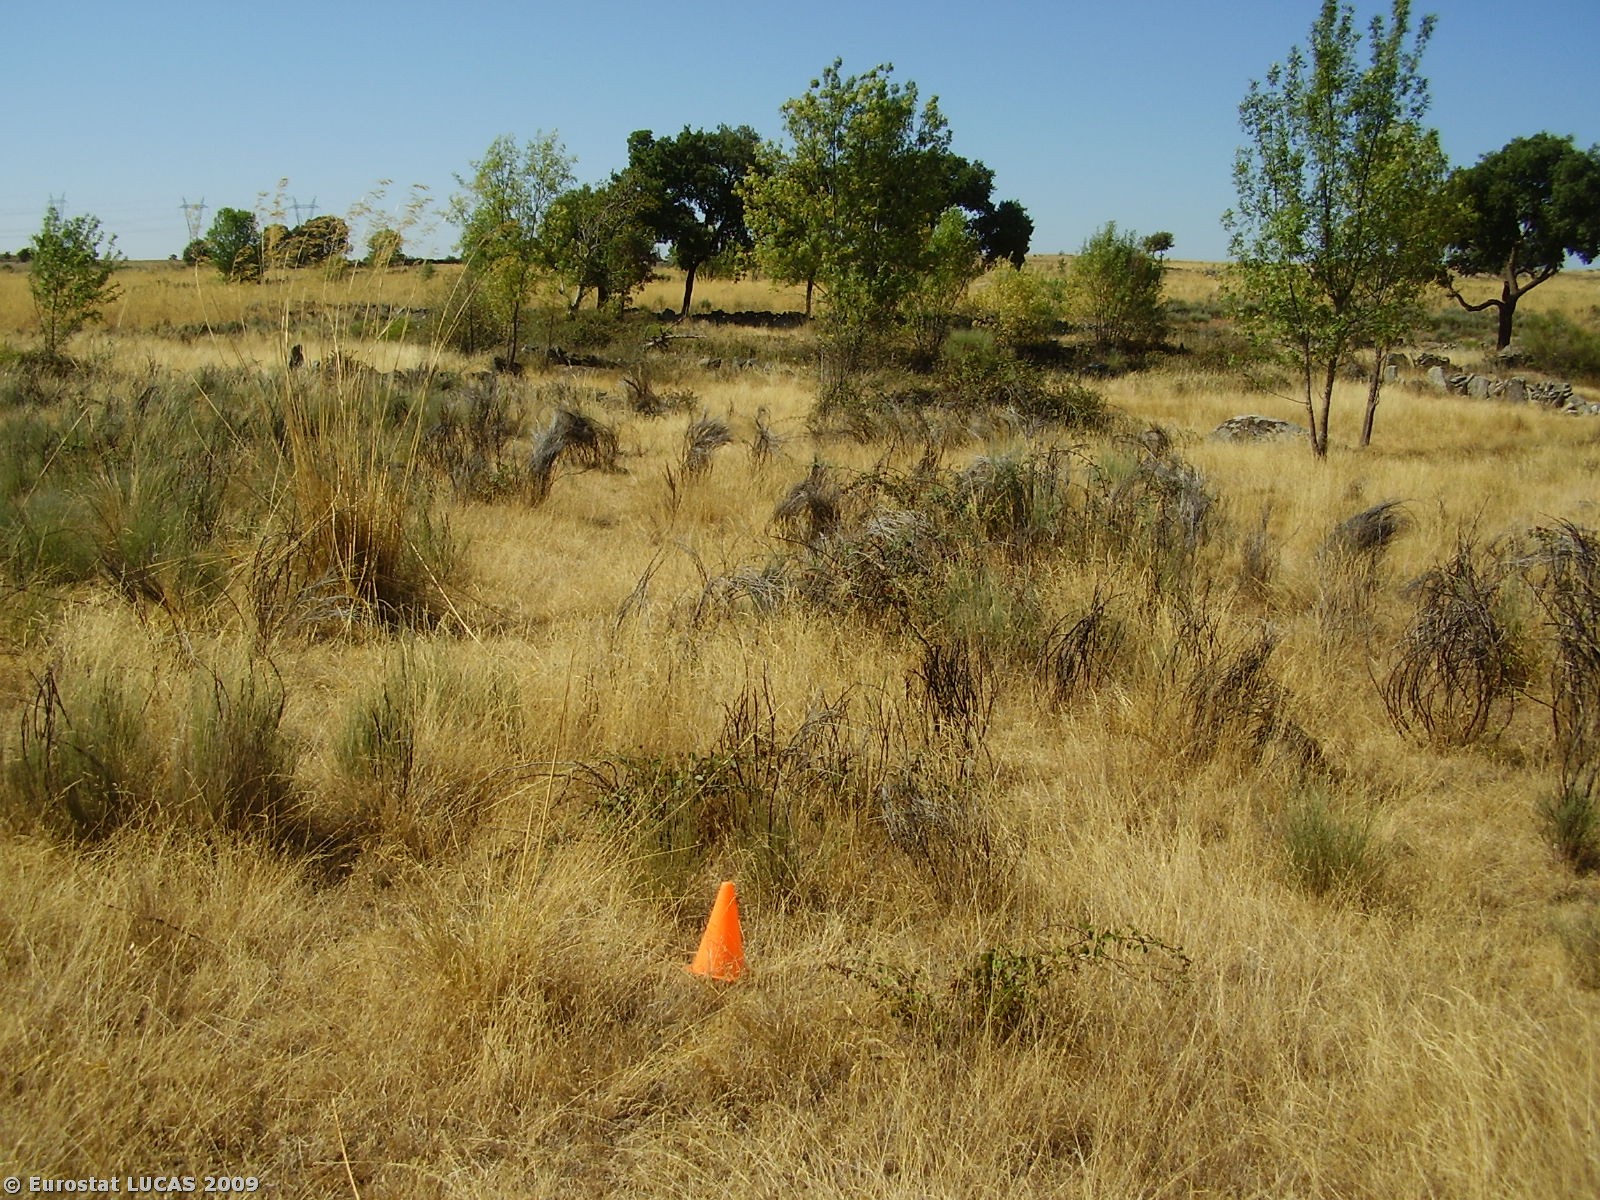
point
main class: Grassland
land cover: Spontaneously vegetated surfaces
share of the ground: > 75 %
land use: Fallow land
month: August
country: PT
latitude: 41.2376
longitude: -6.7001
